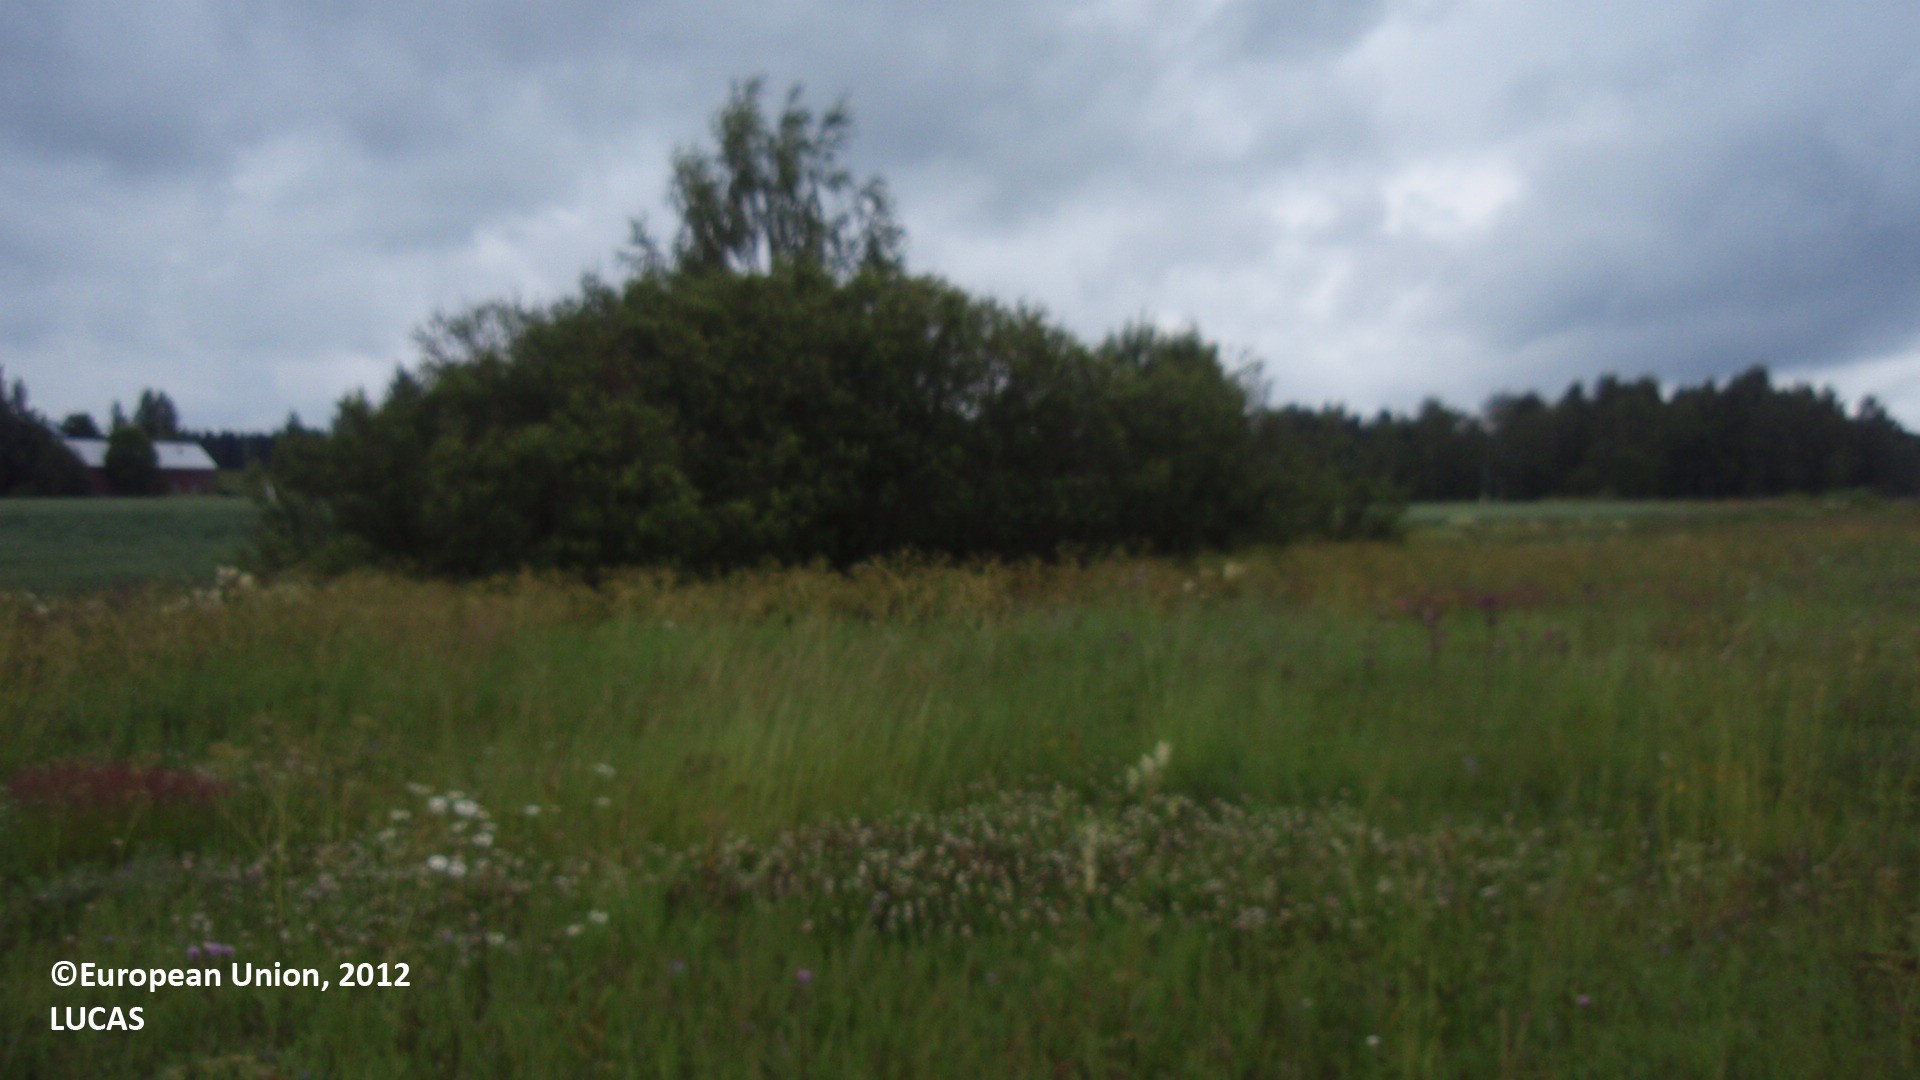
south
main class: Grassland
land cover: Grassland without tree/shrub cover
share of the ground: > 75 %
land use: Fallow land
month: July
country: FI
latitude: 61.0923
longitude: 28.5202
